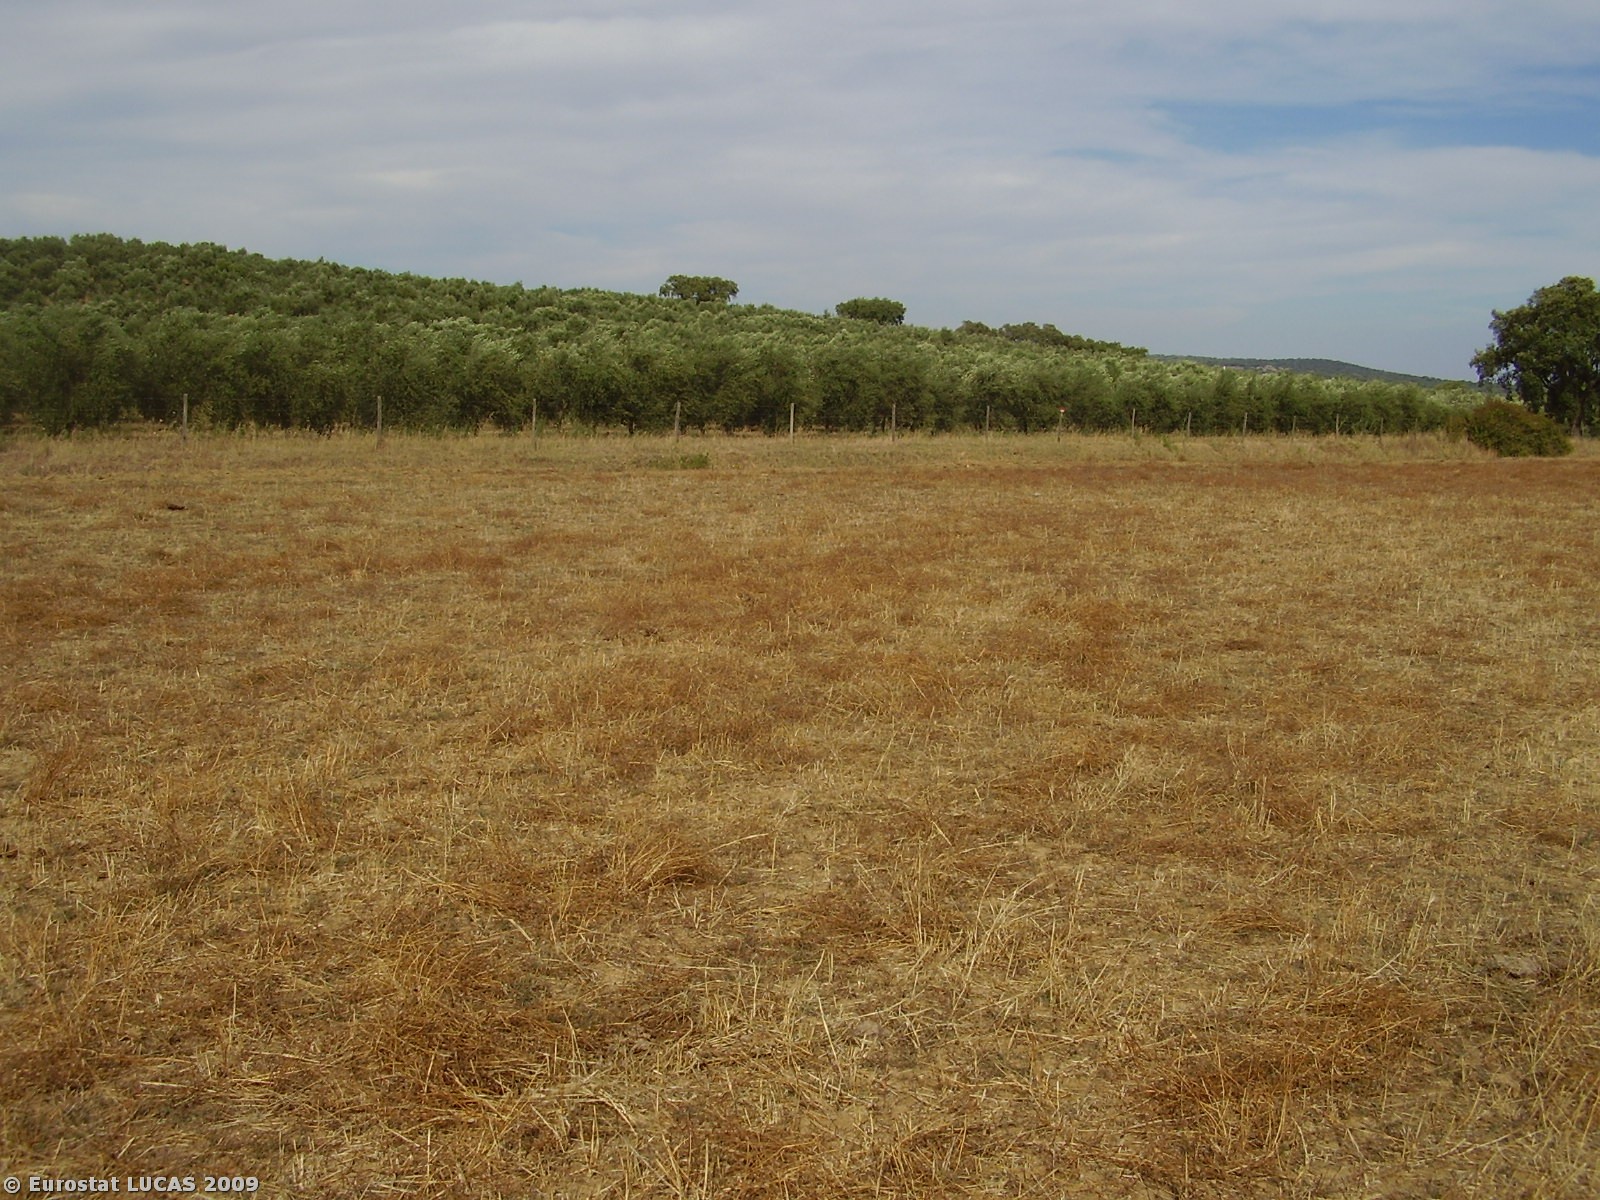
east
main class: Grassland
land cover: Grassland without tree/shrub cover
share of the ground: > 75 %
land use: Agriculture (excluding fallow land and kitchen gardens)
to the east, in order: Grassland without tree/shrub cover; Rivers and streams; Grassland without tree/shrub cover; Fences; Spontaneously vegetated surfaces; Olive groves
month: July
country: PT
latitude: 38.6895
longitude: -7.8485
